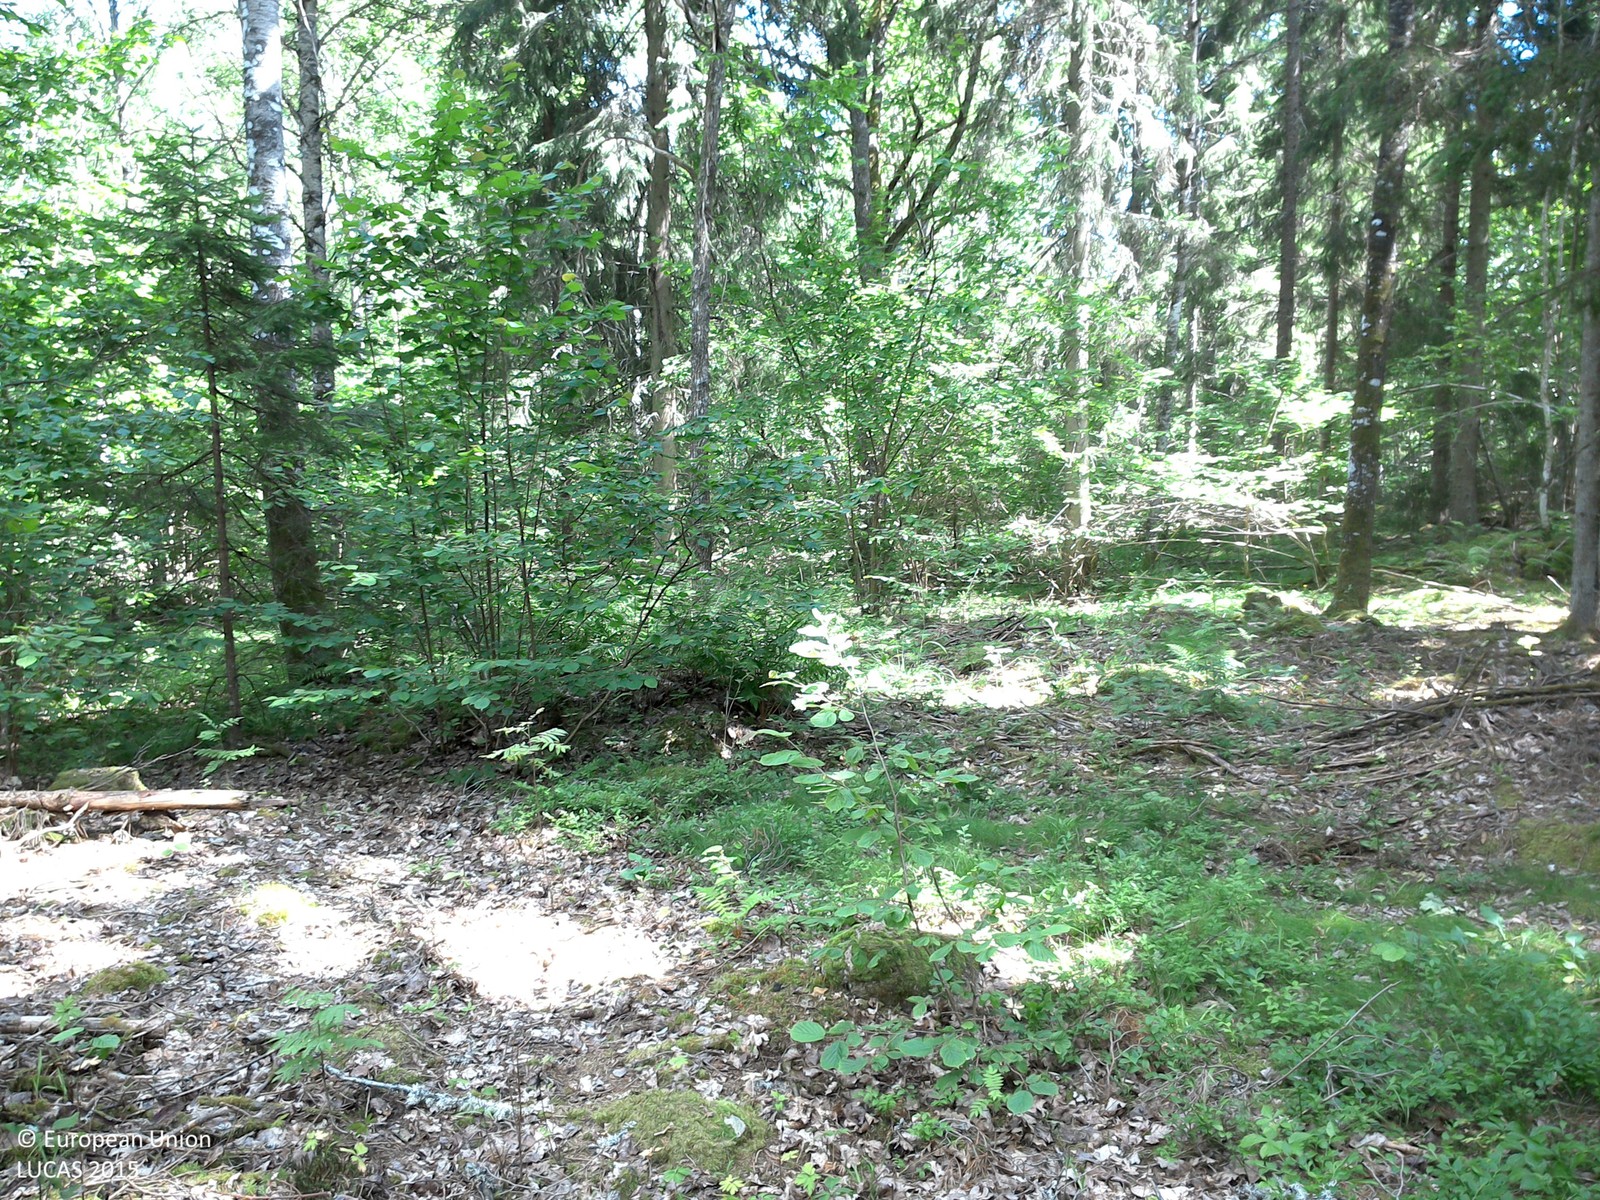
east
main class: Woodland
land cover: Spruce dominated mixed woodland
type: boreal forest
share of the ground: 50 - 75 %
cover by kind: coniferous forest trees 50 %, broadleaved forest trees 20 %, herbaceous plants 20 %, shrubs 10 %
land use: Forestry
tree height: > 5 m
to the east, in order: Spruce dominated mixed woodland; Broadleaved woodland; Dry stone walls; Broadleaved woodland; Dry stone walls; Broadleaved woodland; Paved roads, cycling and walking lanes; Broadleaved woodland; Spruce dominated coniferous woodland
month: July
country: SE
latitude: 58.0453
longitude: 14.7550
